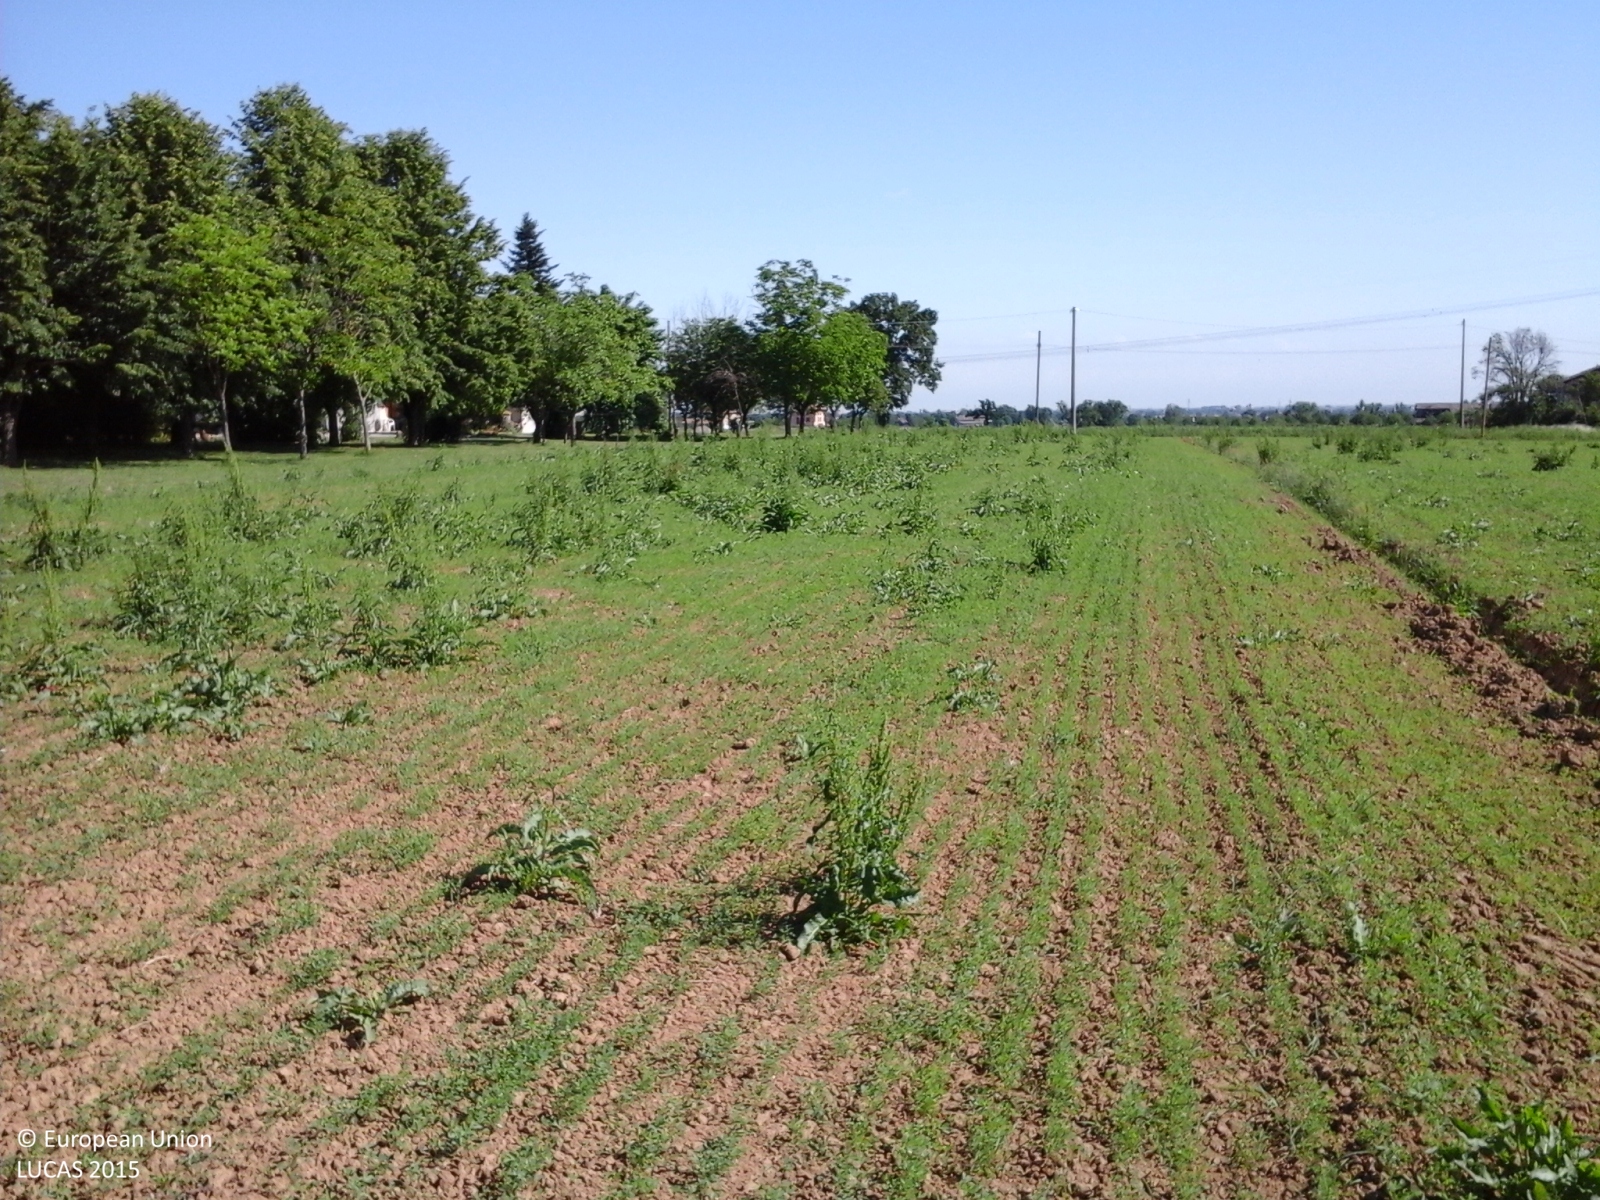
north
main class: Cropland
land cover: Lucerne
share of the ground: 50 - 75 %
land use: Agriculture (excluding fallow land and kitchen gardens)
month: May
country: IT
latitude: 44.6373
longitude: 10.6164
